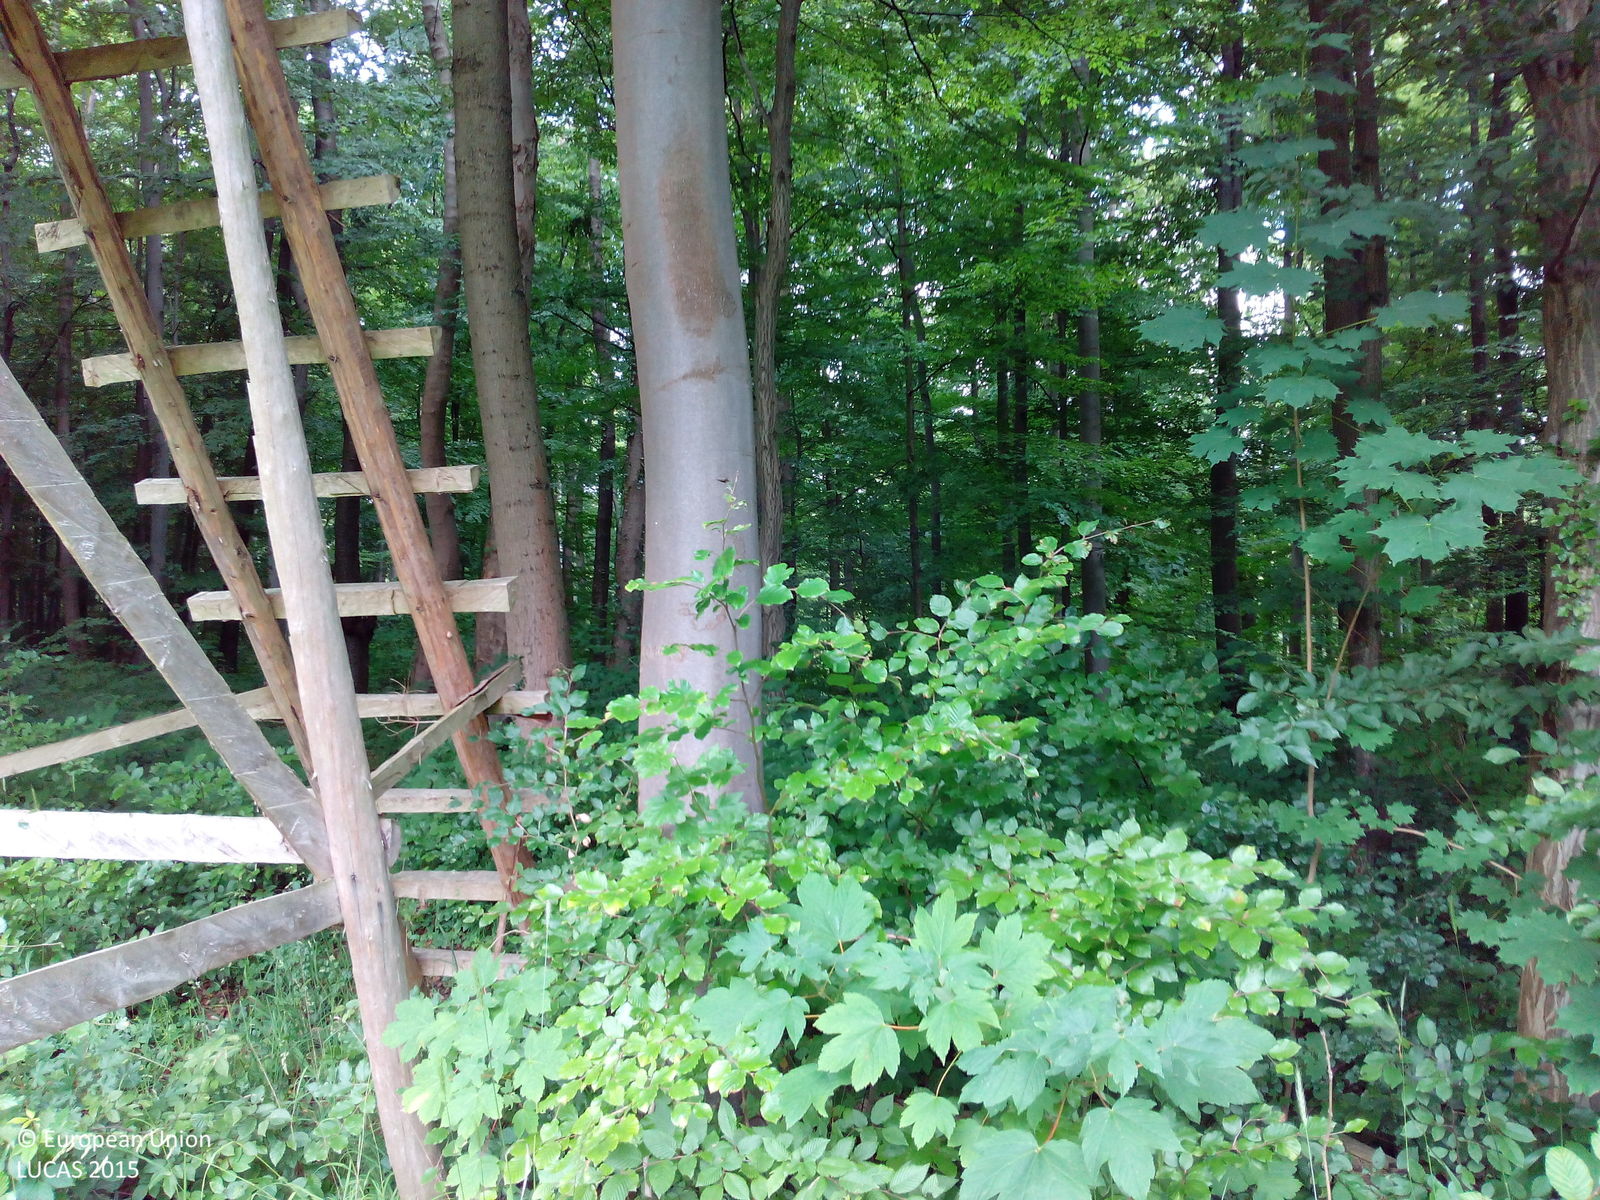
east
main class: Artificial land
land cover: Other artificial areas
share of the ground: > 75 %
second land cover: Shrubland with sparse tree cover
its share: > 75 %
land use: Electricity, gas and thermal power distribution
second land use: Forestry
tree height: > 5 m
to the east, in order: Artificial constructions in urban areas; Shrubland with sparse tree cover; Broadleaved woodland; Tracks; Broadleaved woodland; Tracks; Broadleaved woodland; Tracks; Broadleaved woodland; Abandoned hedges; Shruby margins
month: July
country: DE
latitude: 51.5686
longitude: 9.9567
